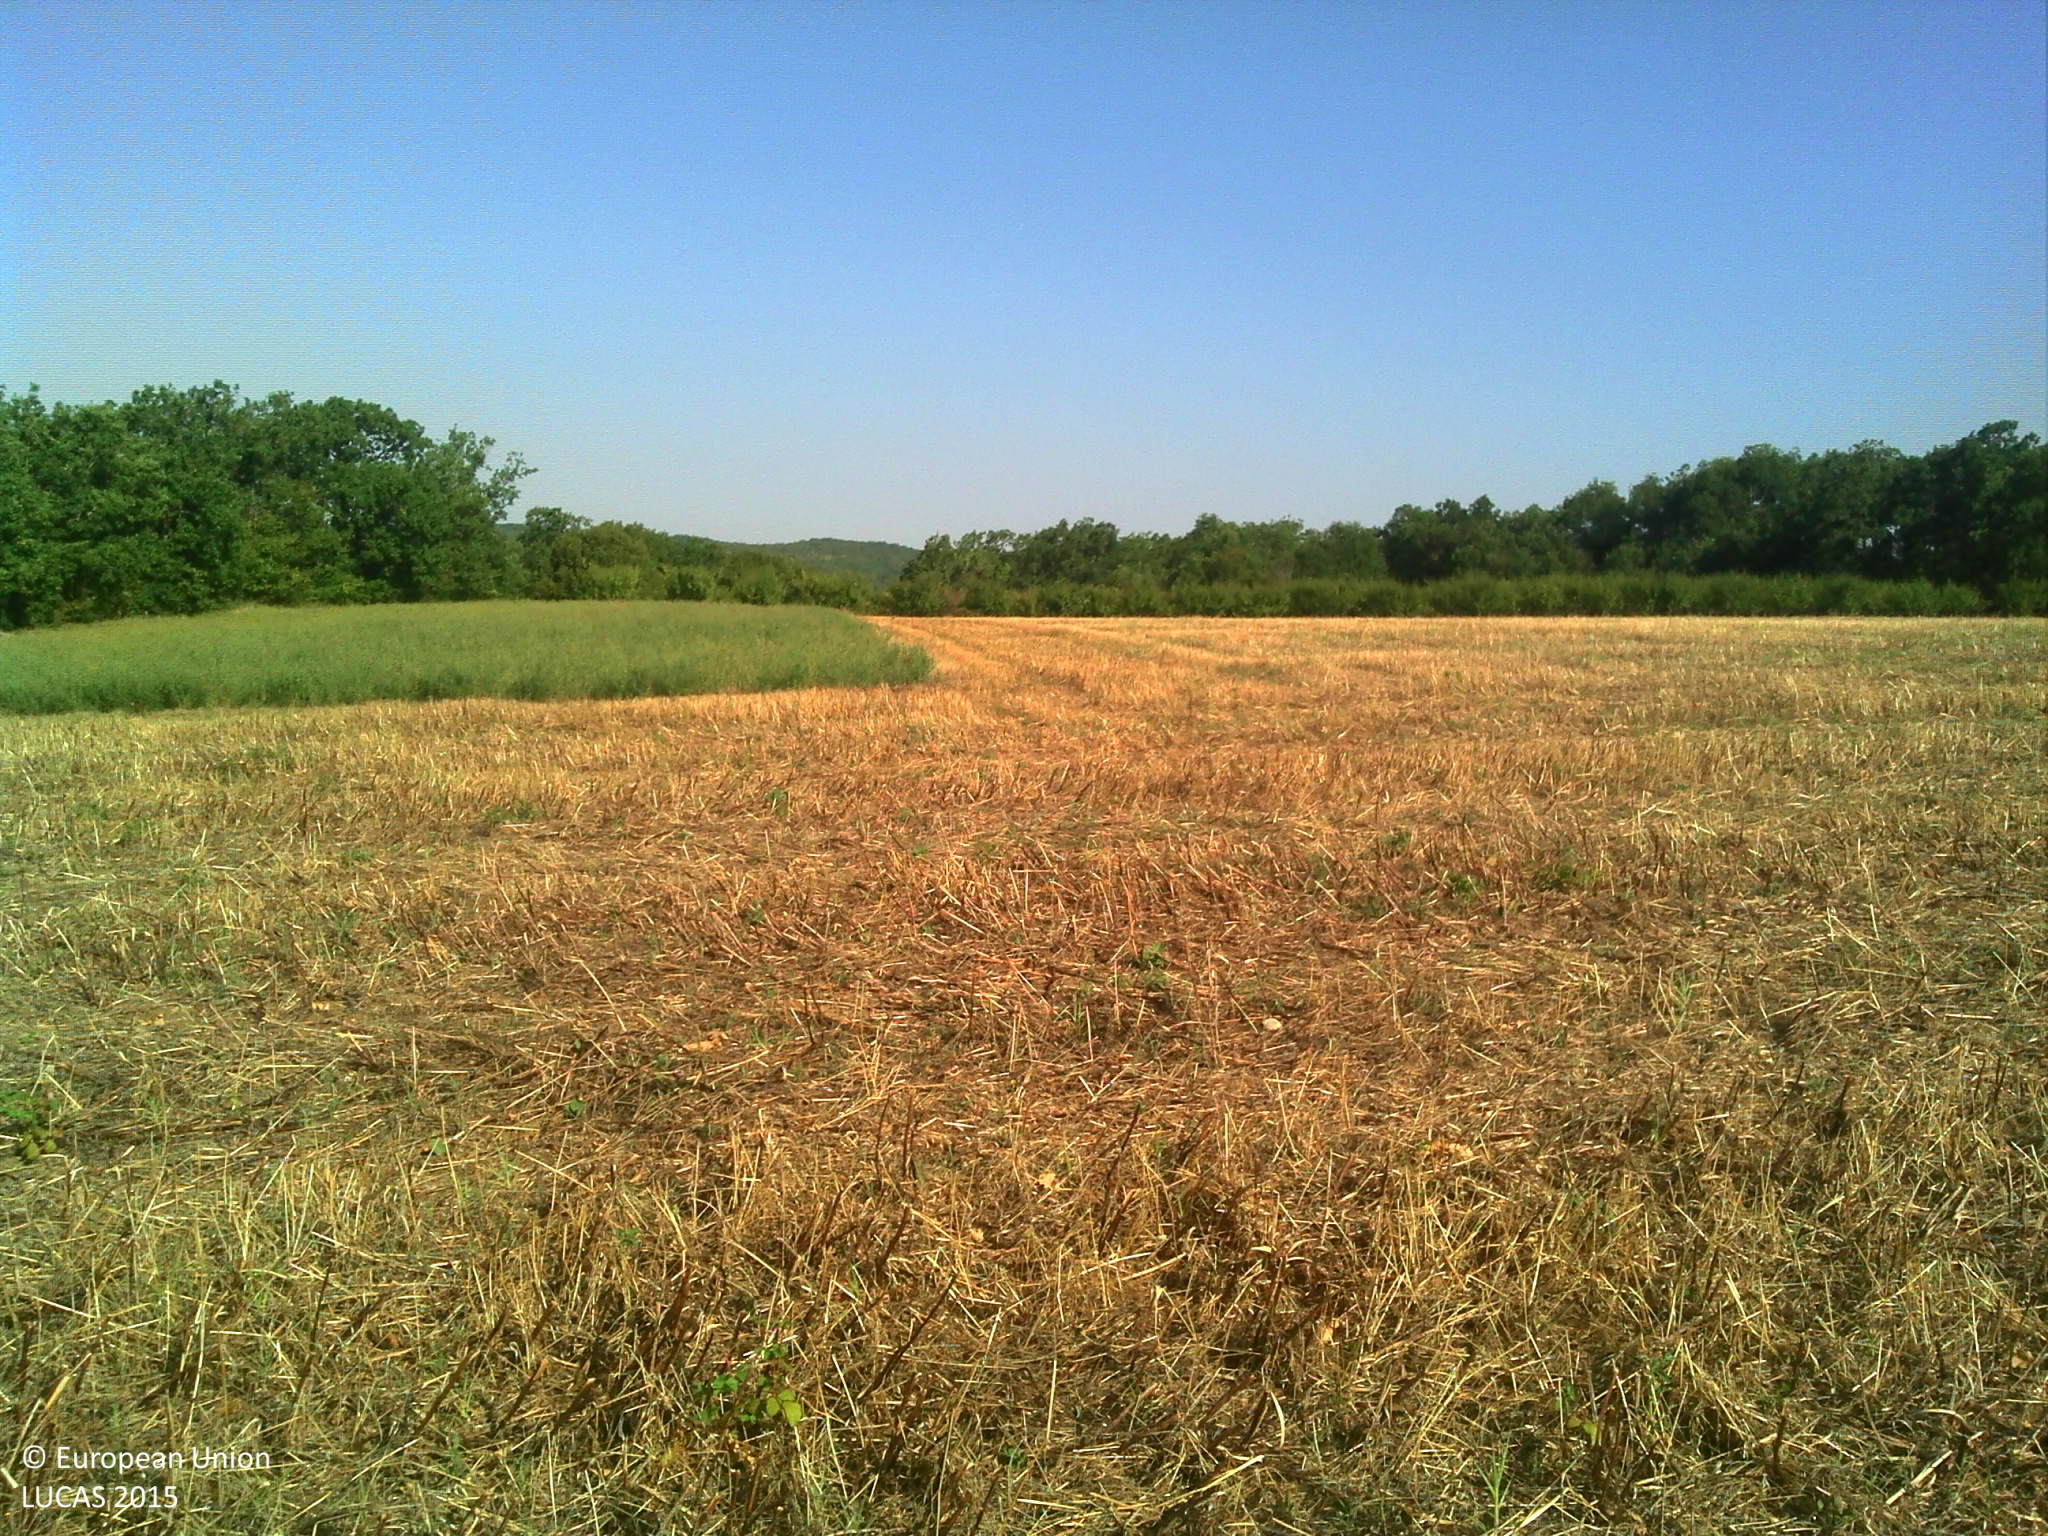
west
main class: Cropland
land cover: Dry pulses
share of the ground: 50 - 75 %
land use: Agriculture (excluding fallow land and kitchen gardens)
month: August
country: FR
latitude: 44.2318
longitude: 1.2218
